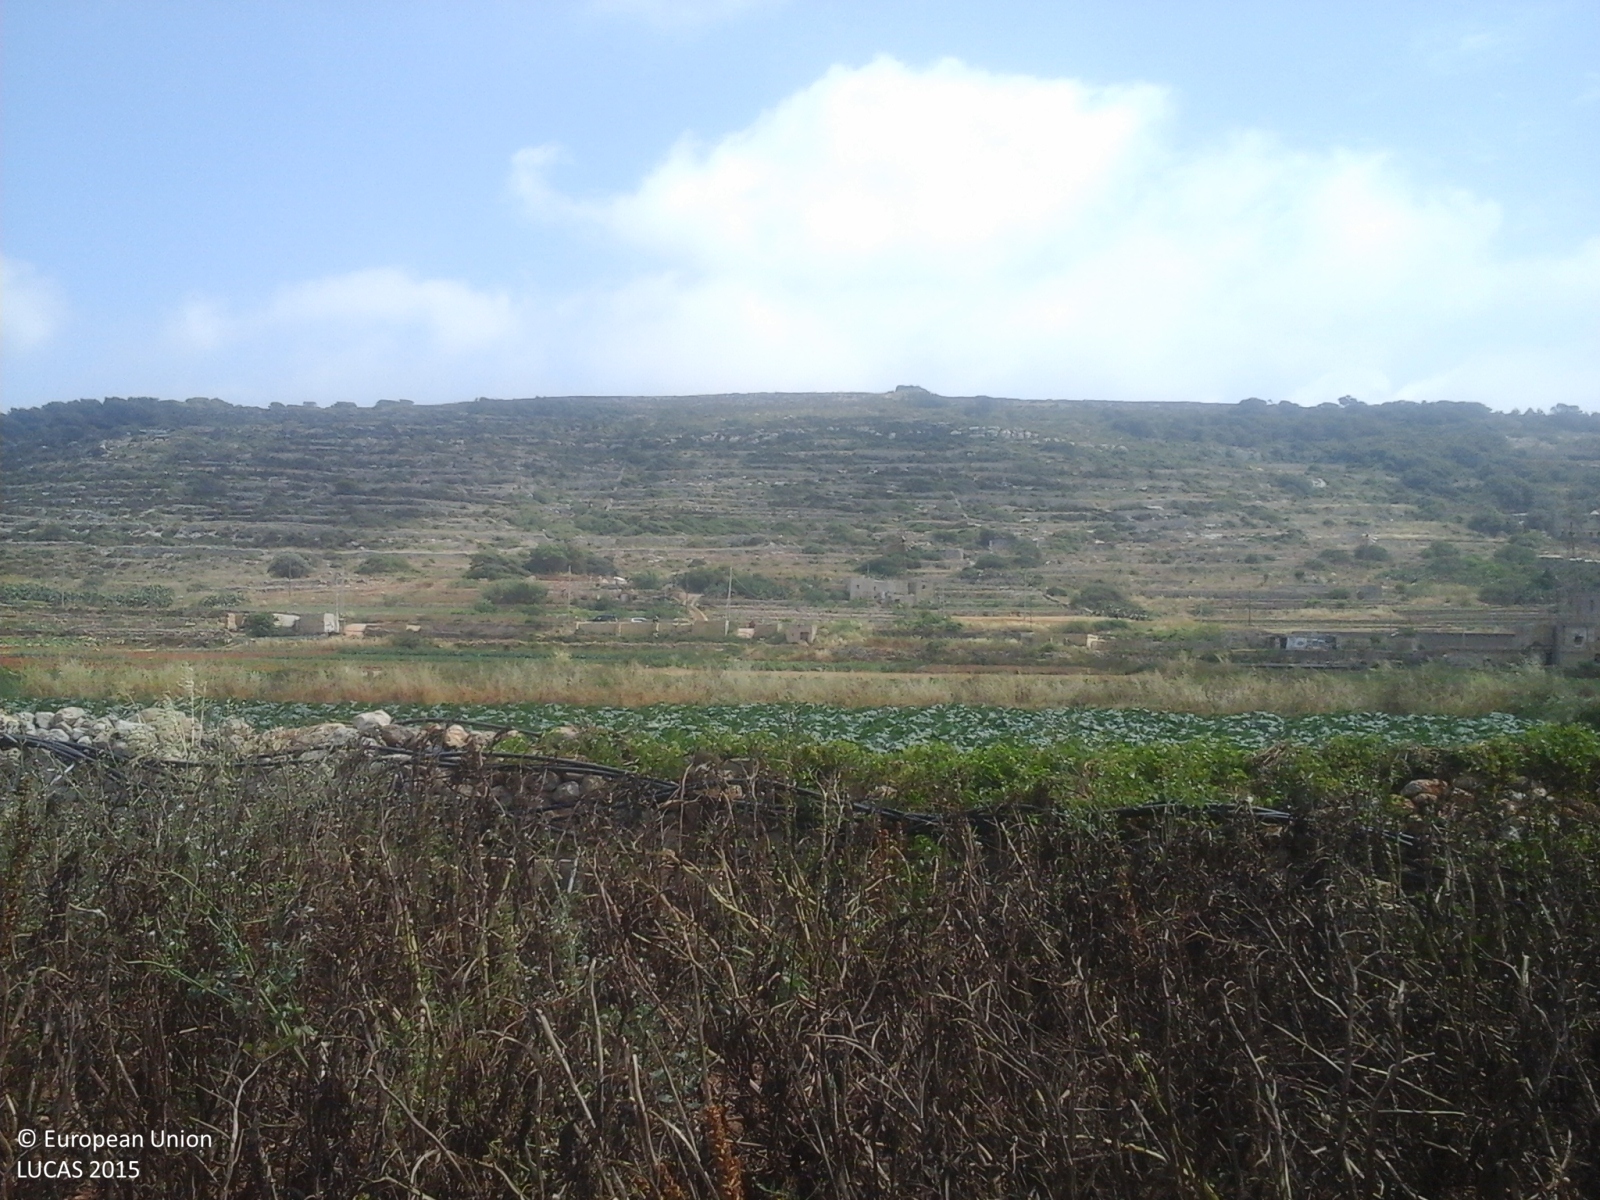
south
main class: Cropland
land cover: Dry pulses
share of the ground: > 75 %
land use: Agriculture (excluding fallow land and kitchen gardens)
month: May
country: MT
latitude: 35.9371
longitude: 14.3604
